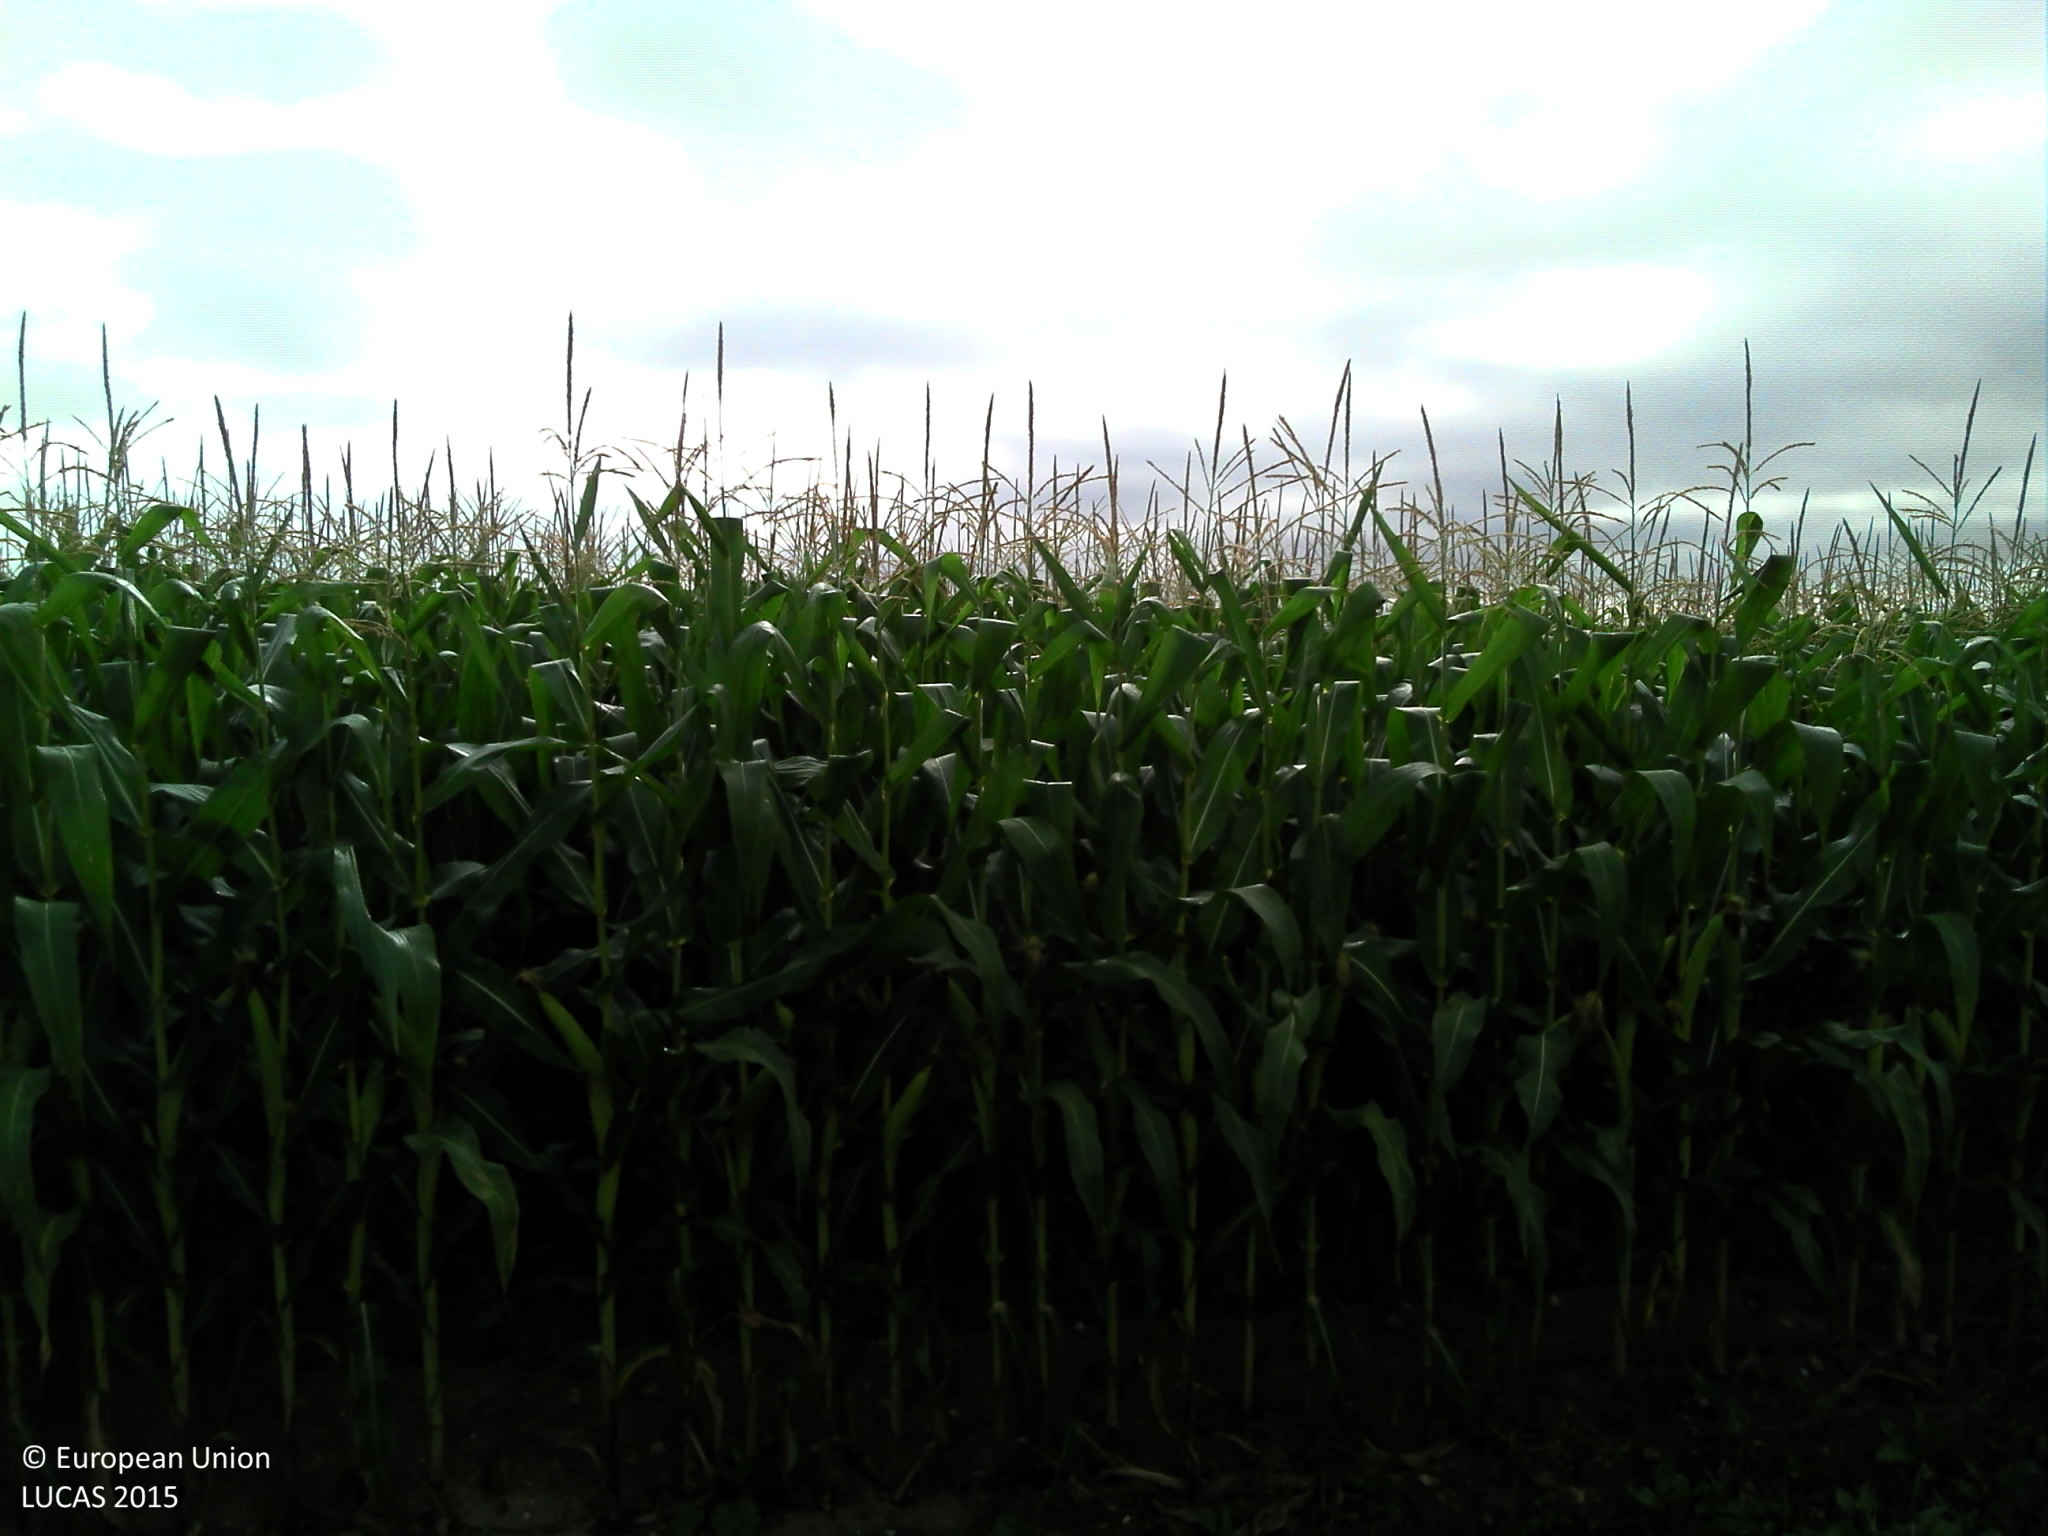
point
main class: Cropland
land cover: Maize
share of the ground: > 75 %
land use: Agriculture (excluding fallow land and kitchen gardens)
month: July
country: FR
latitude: 46.3098
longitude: 0.5174
